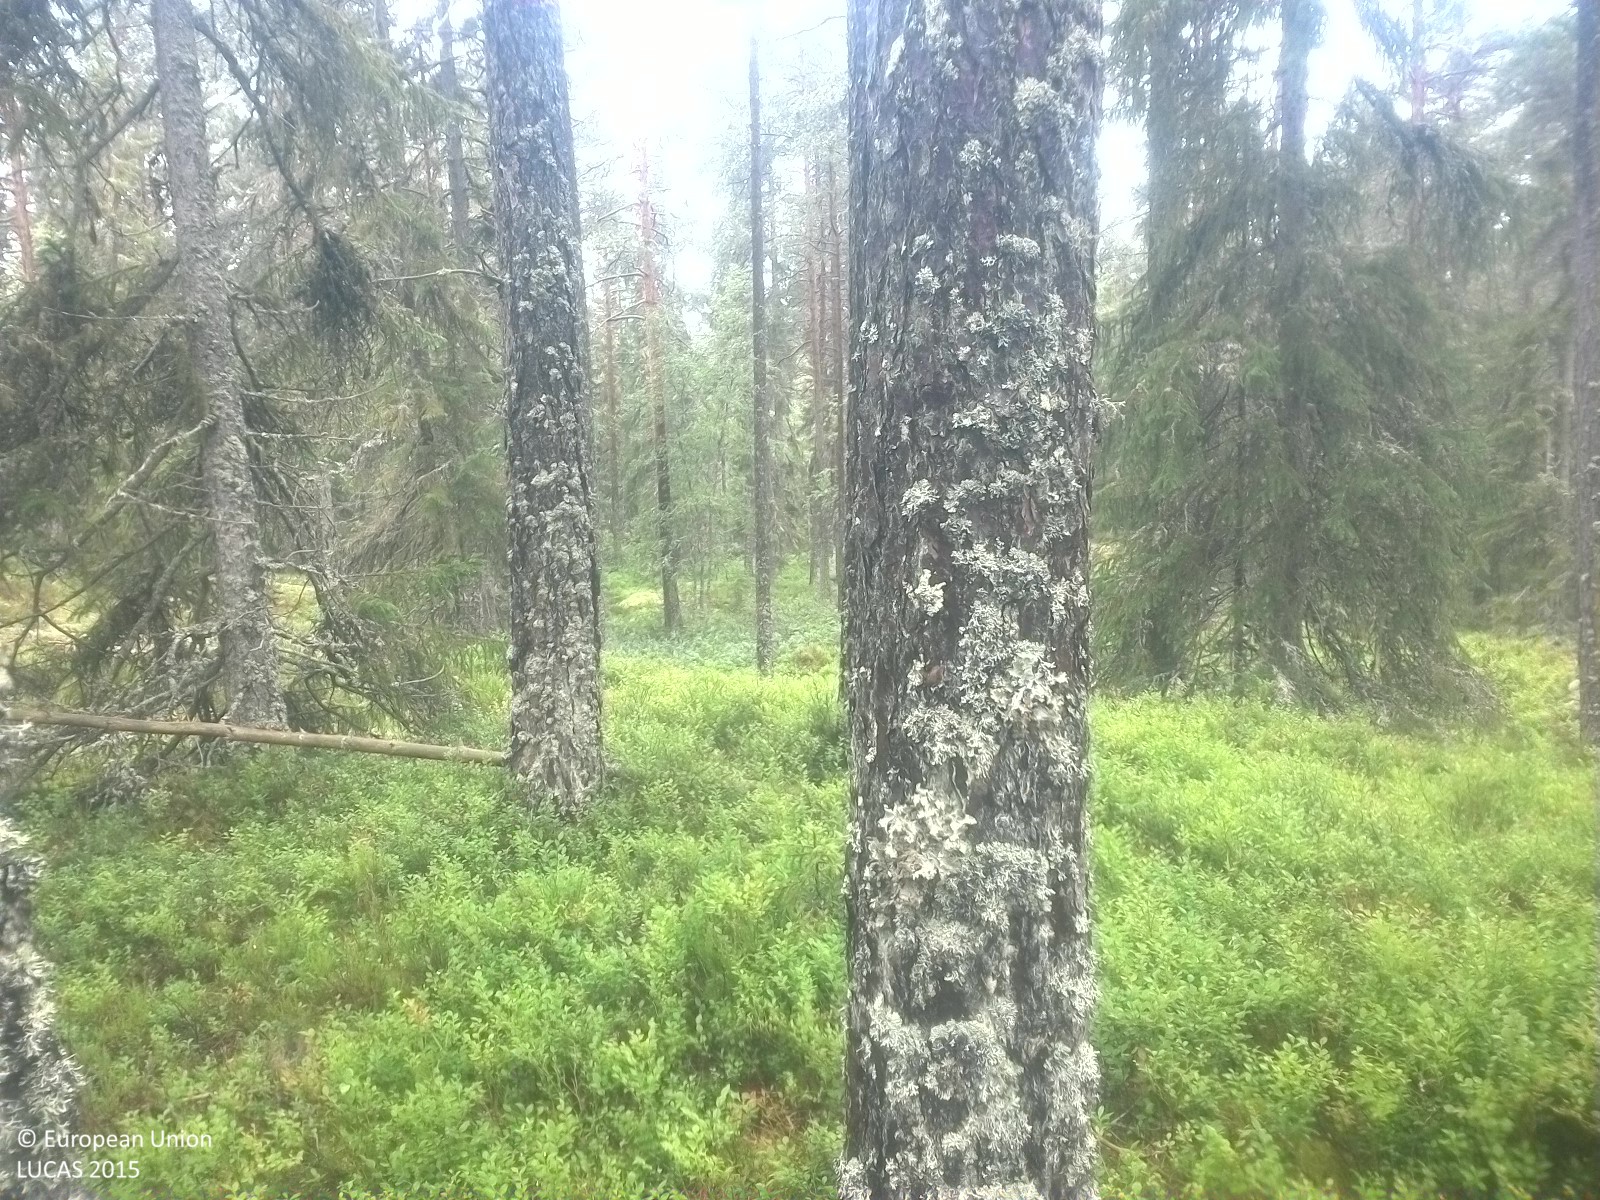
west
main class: Woodland
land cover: Pine dominated coniferous woodland
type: boreal forest
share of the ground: 10 - 25 %
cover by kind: herbaceous plants 60 %, coniferous forest trees 20 %, shrubs 10 %, lichens and mosses 10 %
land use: Forestry
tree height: > 5 m
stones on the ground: 25 - 50 %
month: July
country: SE
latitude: 58.7707
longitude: 15.1289
